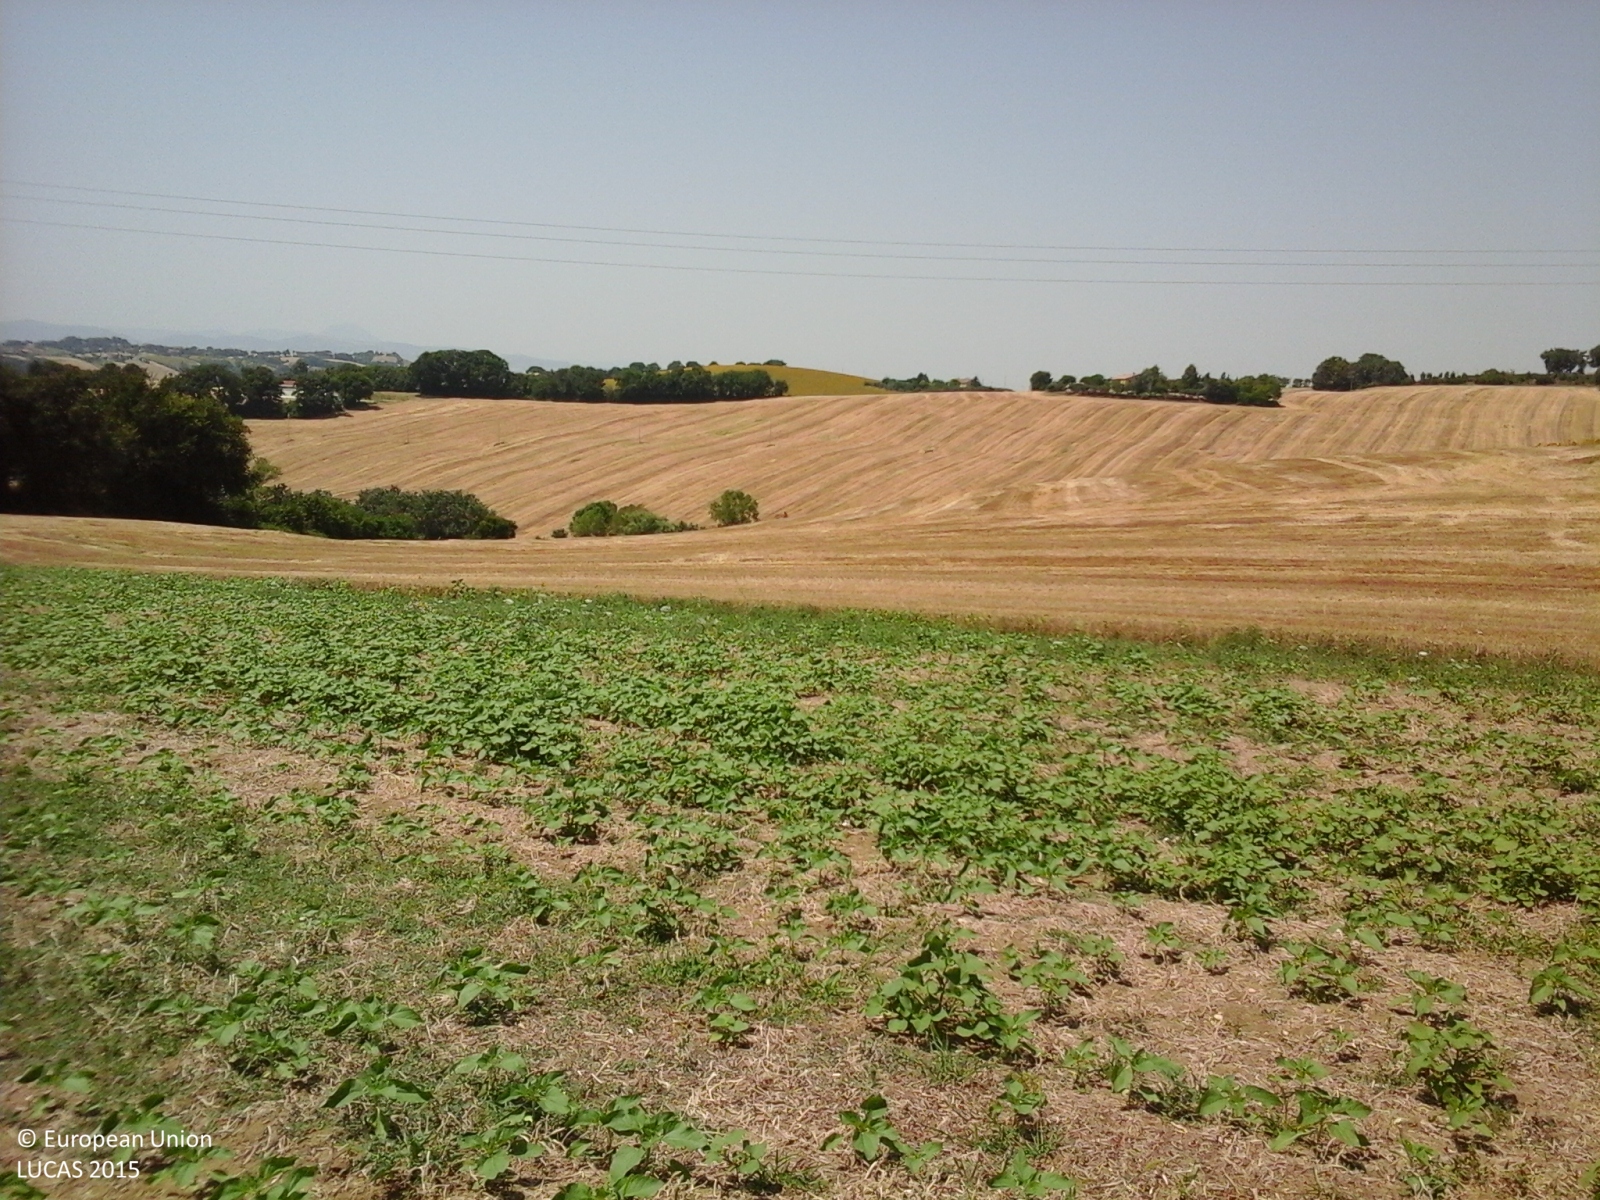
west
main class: Cropland
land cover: Sunflower
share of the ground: 25 - 50 %
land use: Agriculture (excluding fallow land and kitchen gardens)
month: July
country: IT
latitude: 43.3892
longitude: 13.4849
